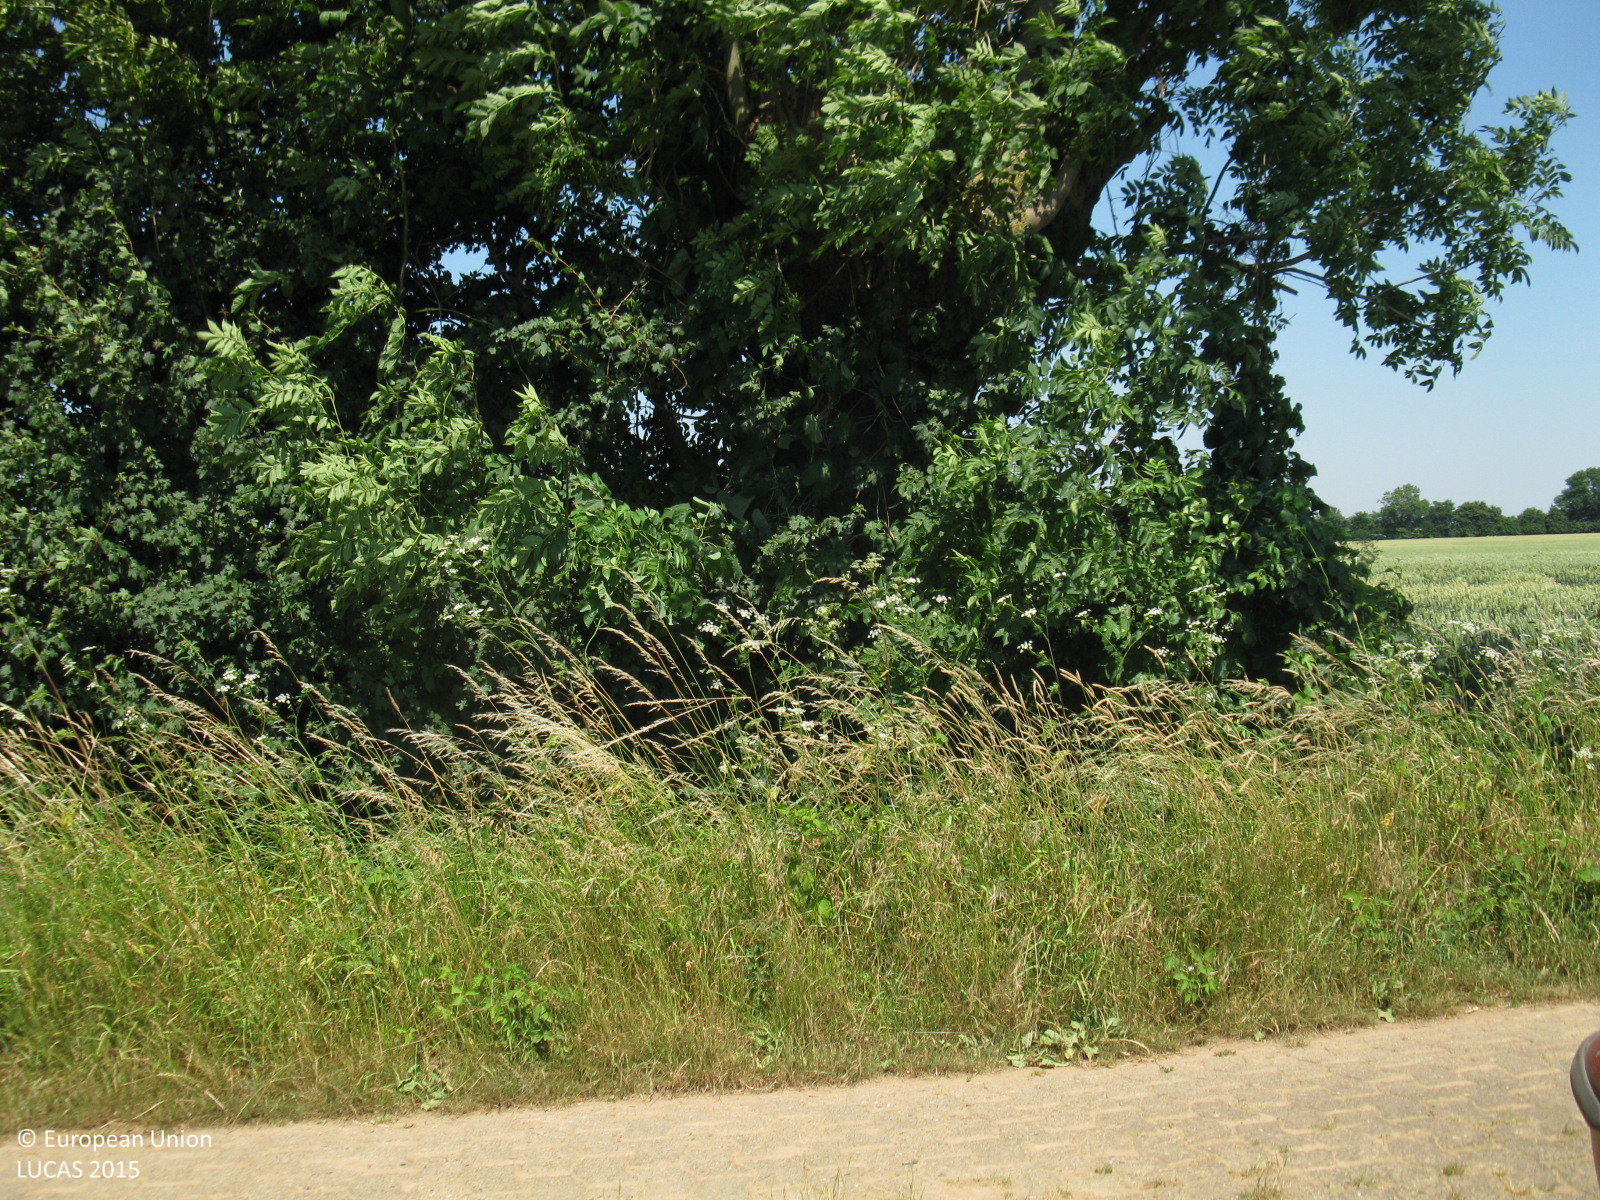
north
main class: Cropland
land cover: Rape and turnip rape
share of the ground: > 75 %
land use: Agriculture (excluding fallow land and kitchen gardens)
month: July
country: DE
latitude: 52.8779
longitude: 9.1831
